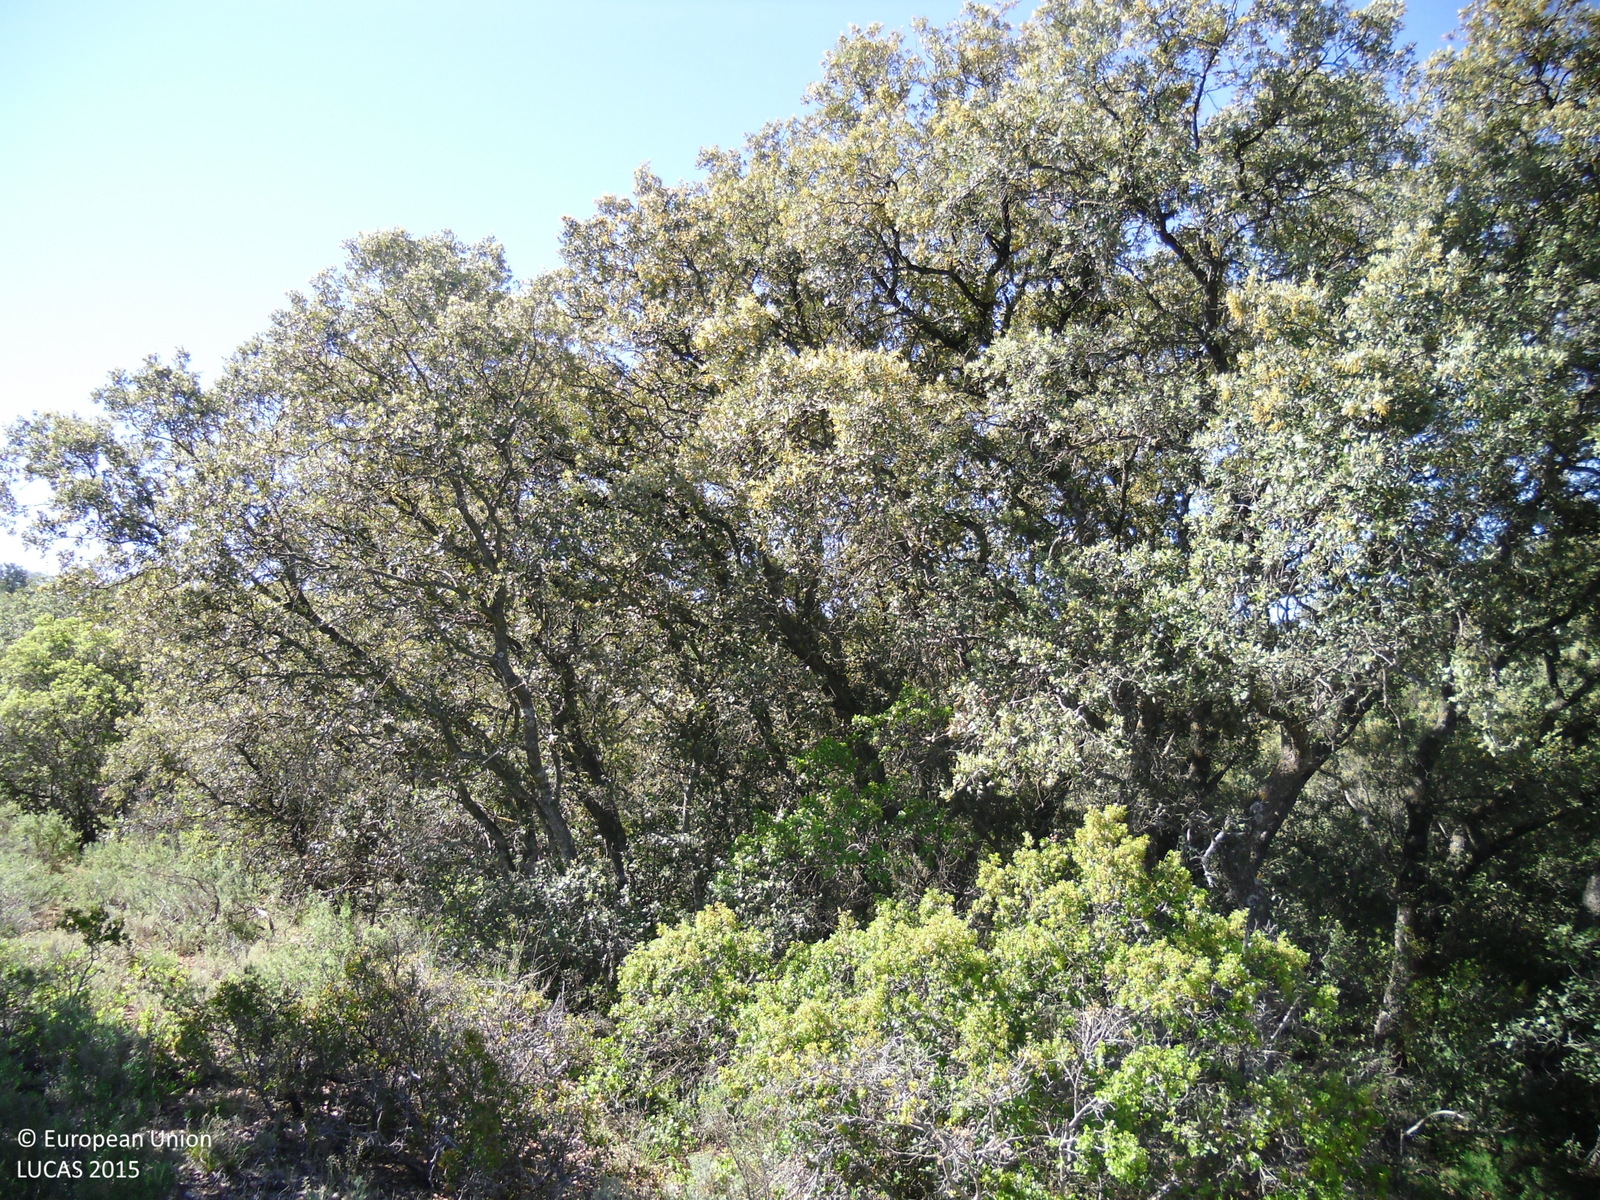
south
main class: Woodland
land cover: Broadleaved woodland
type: broadleaved evergreen forest
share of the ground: > 75 %
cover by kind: broadleaved forest trees 80 %, shrubs 10 %, herbaceous plants 5 %, consolidated bare surface 5 %
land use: Semi-natural and natural areas not in use
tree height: > 5 m
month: May
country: ES
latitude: 40.1822
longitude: -2.8849
